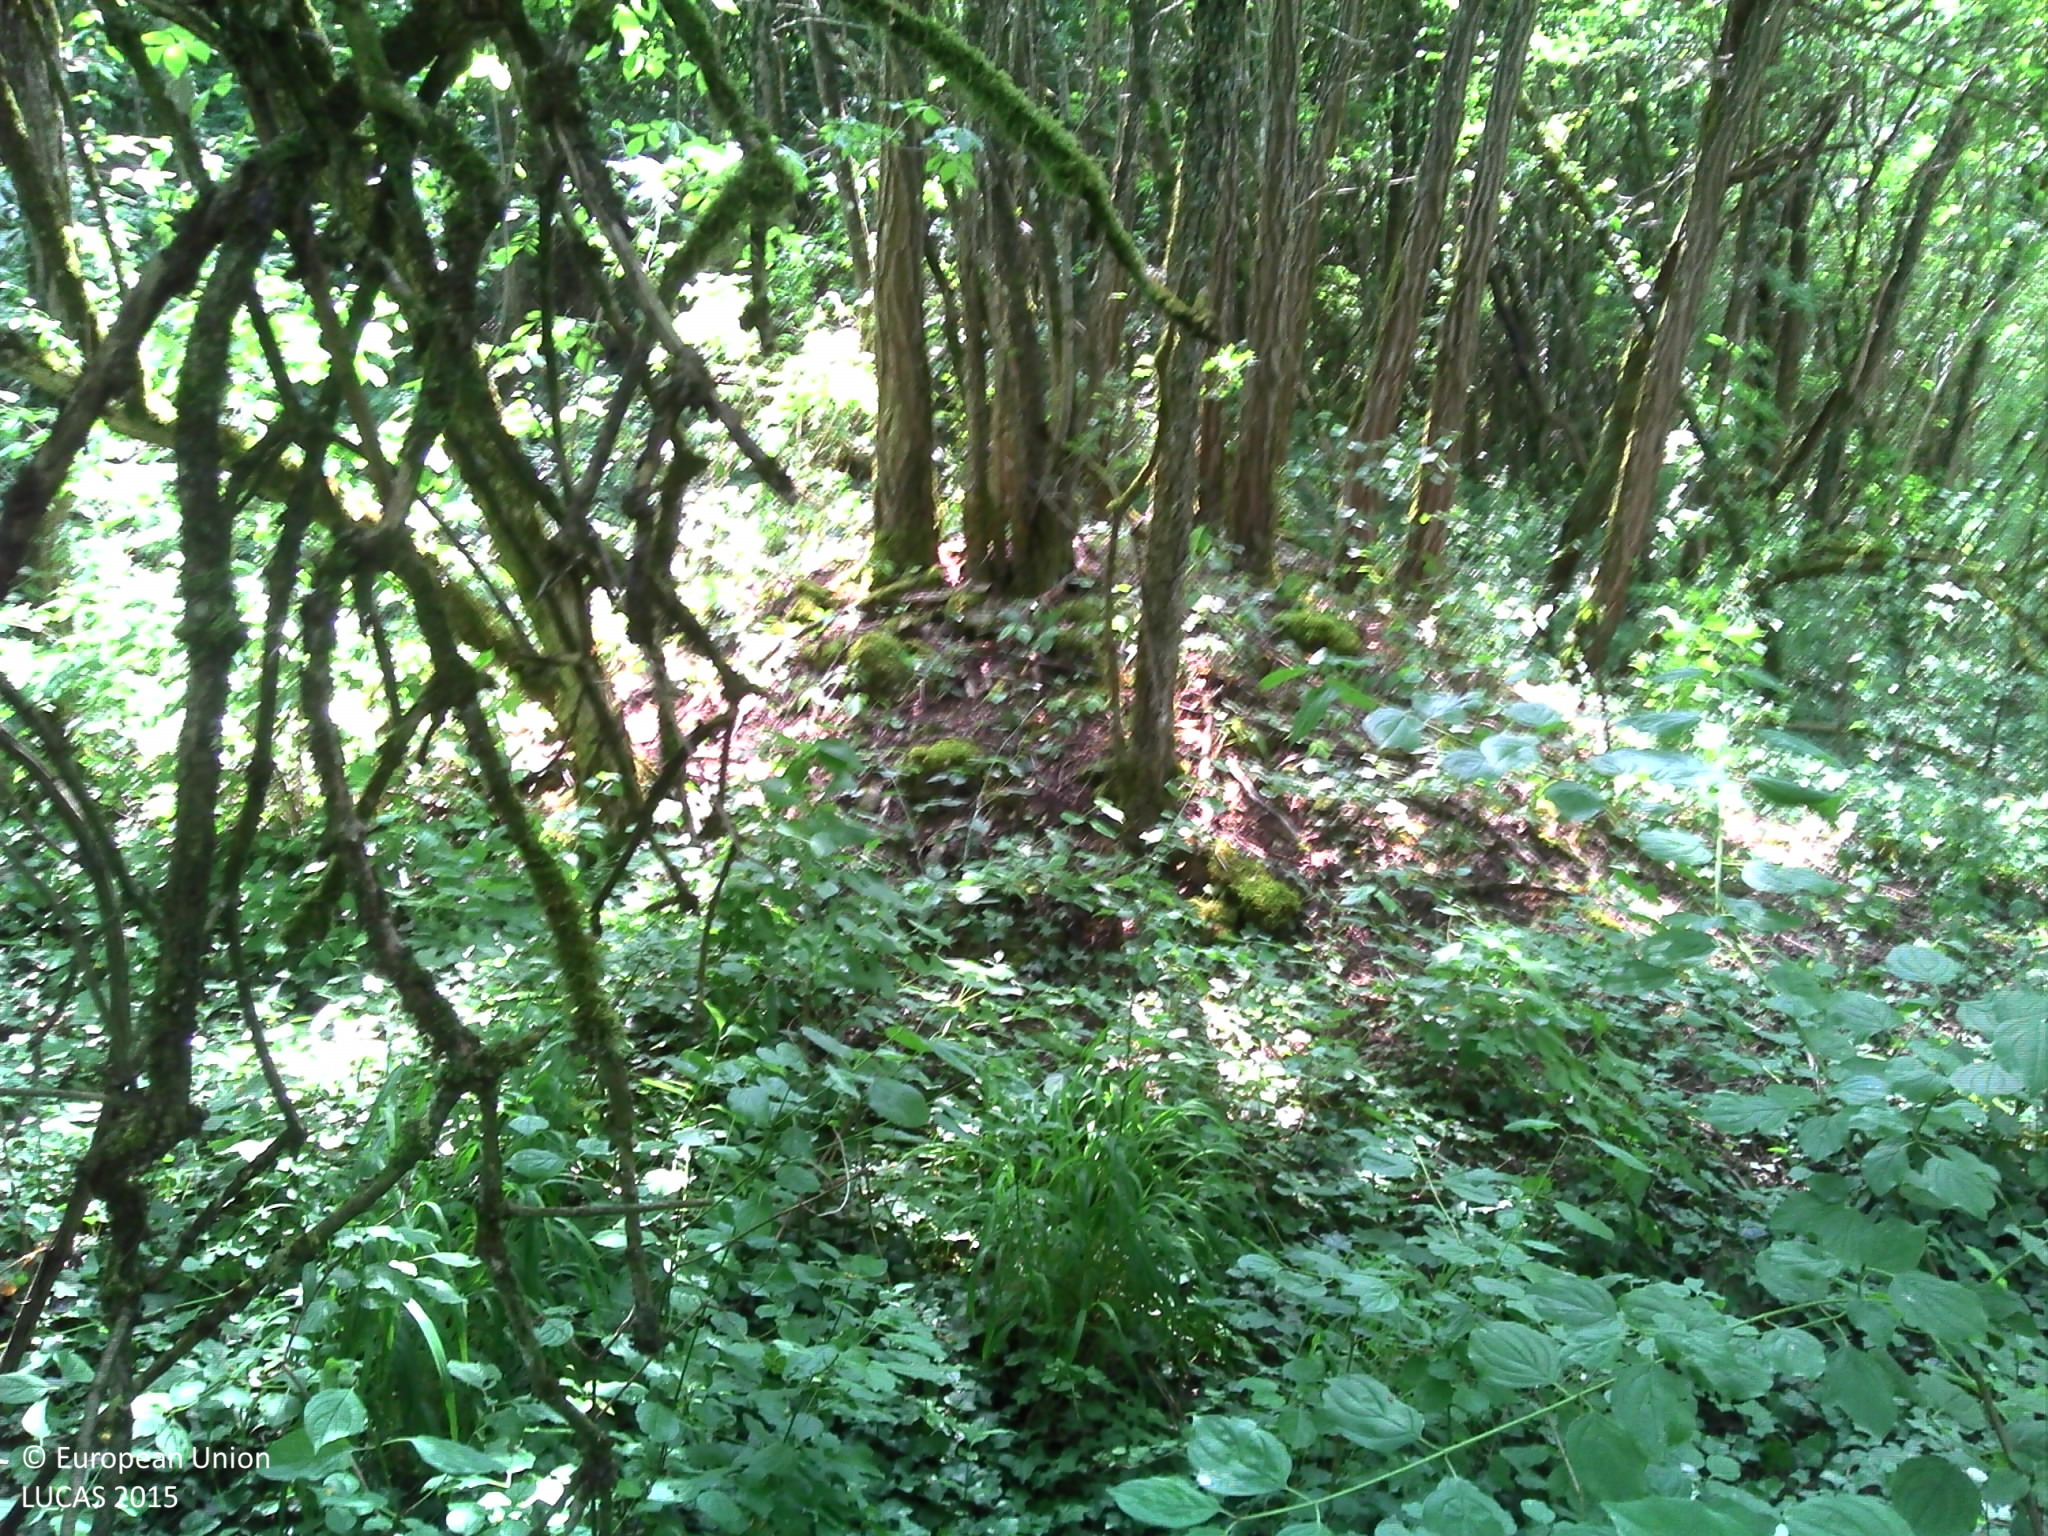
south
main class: Woodland
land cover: Broadleaved woodland
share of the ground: > 75 %
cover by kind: broadleaved forest trees 90 %, herbaceous plants 5 %, lichens and mosses 5 %
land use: Semi-natural and natural areas not in use
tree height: < 5 m
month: July
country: FR
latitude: 48.6712
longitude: 5.9395
